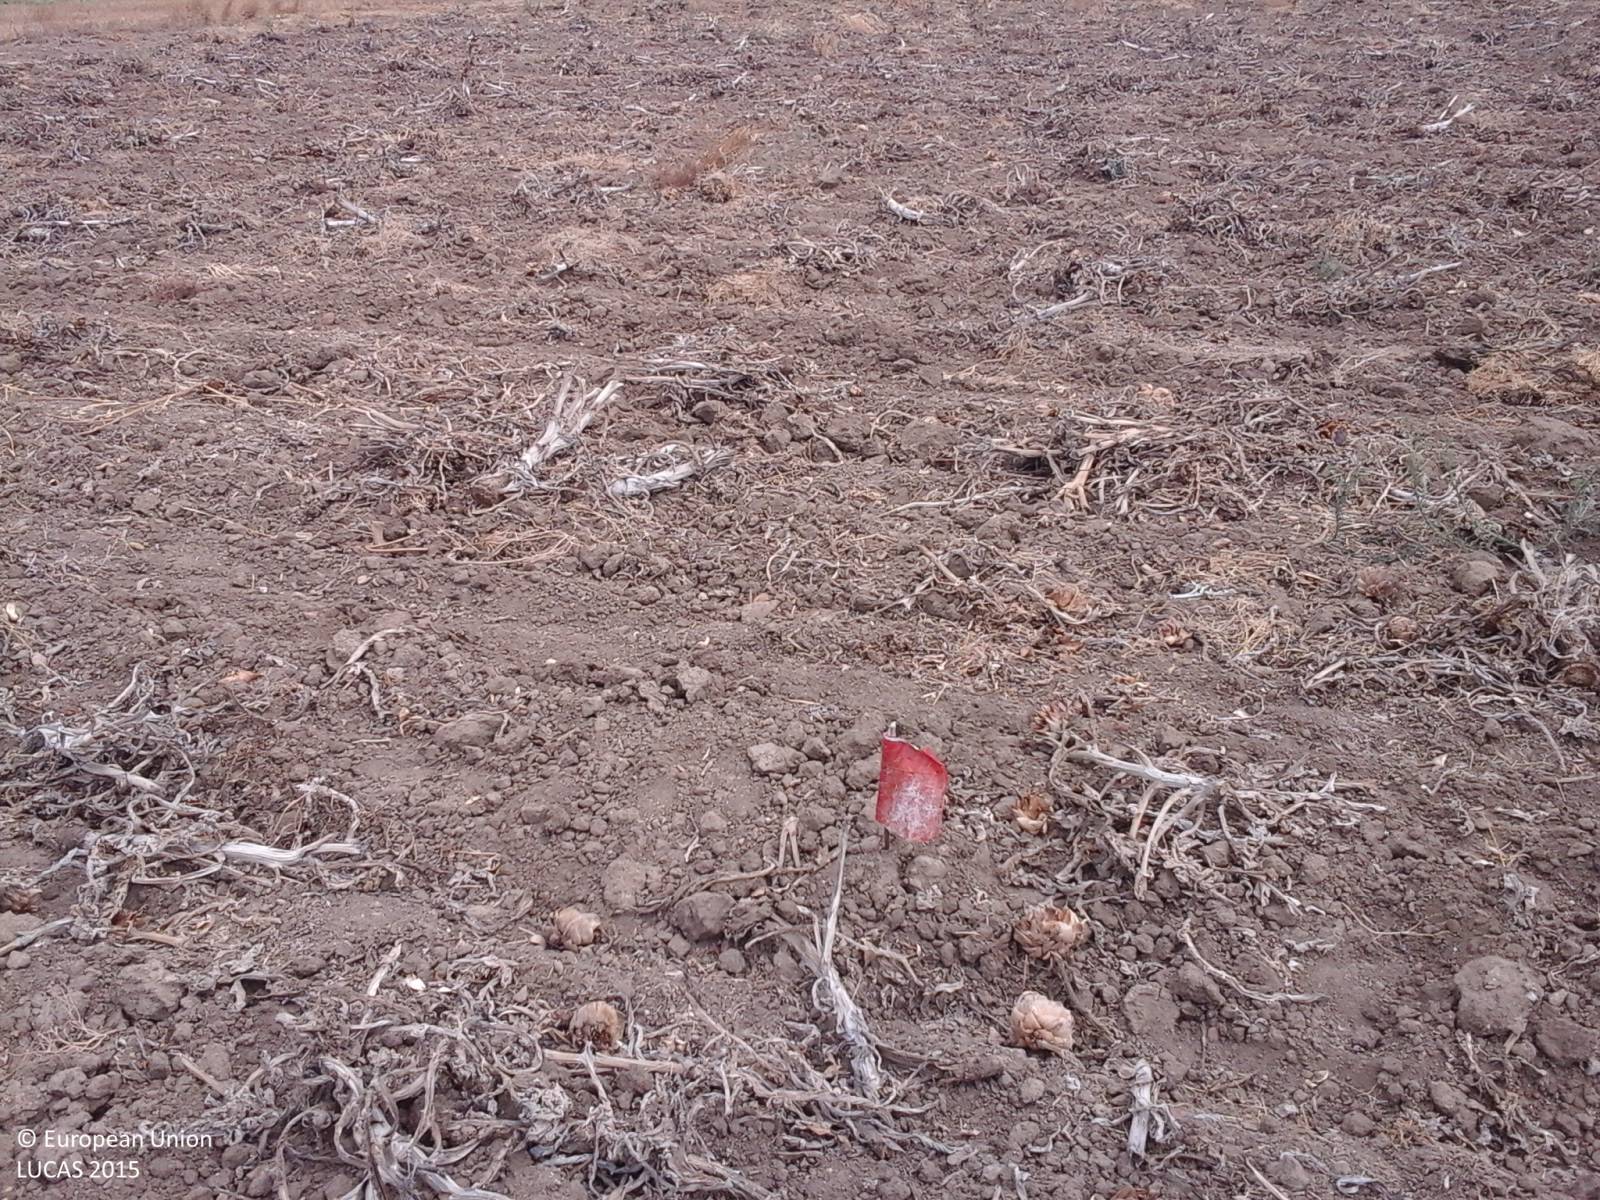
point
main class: Cropland
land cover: Other fresh vegetables
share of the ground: > 75 %
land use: Agriculture (excluding fallow land and kitchen gardens)
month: July
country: IT
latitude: 39.4821
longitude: 8.8790
